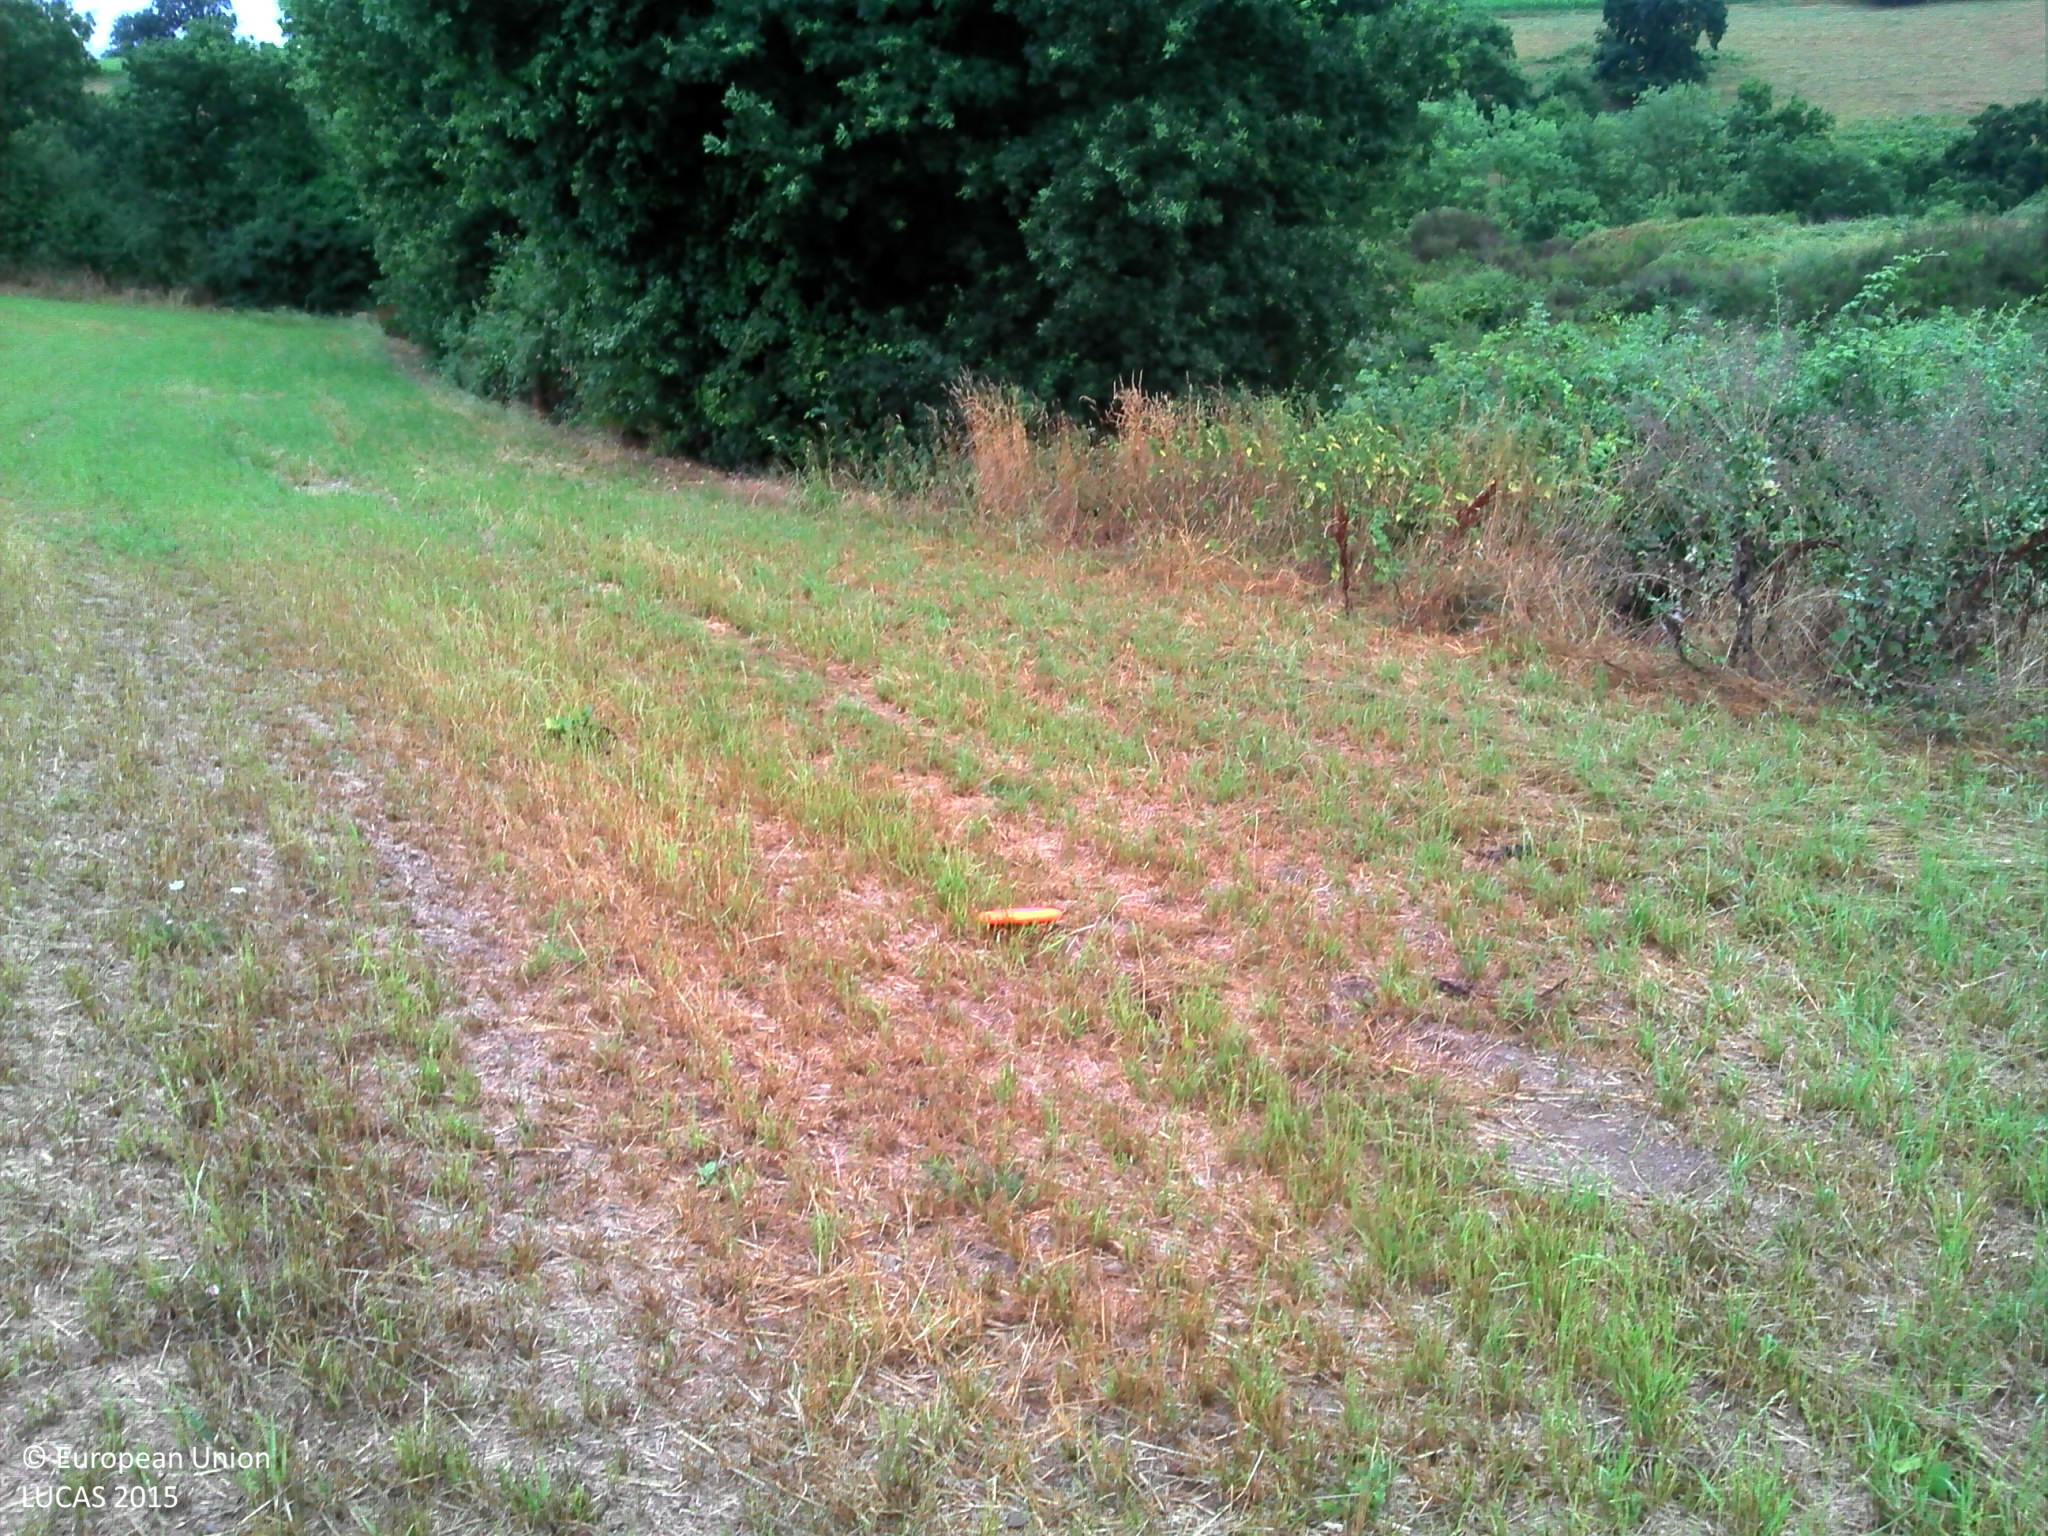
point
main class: Cropland
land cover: Temporary grasslands
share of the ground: > 75 %
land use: Agriculture (excluding fallow land and kitchen gardens)
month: July
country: FR
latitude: 48.3153
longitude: -0.1577
